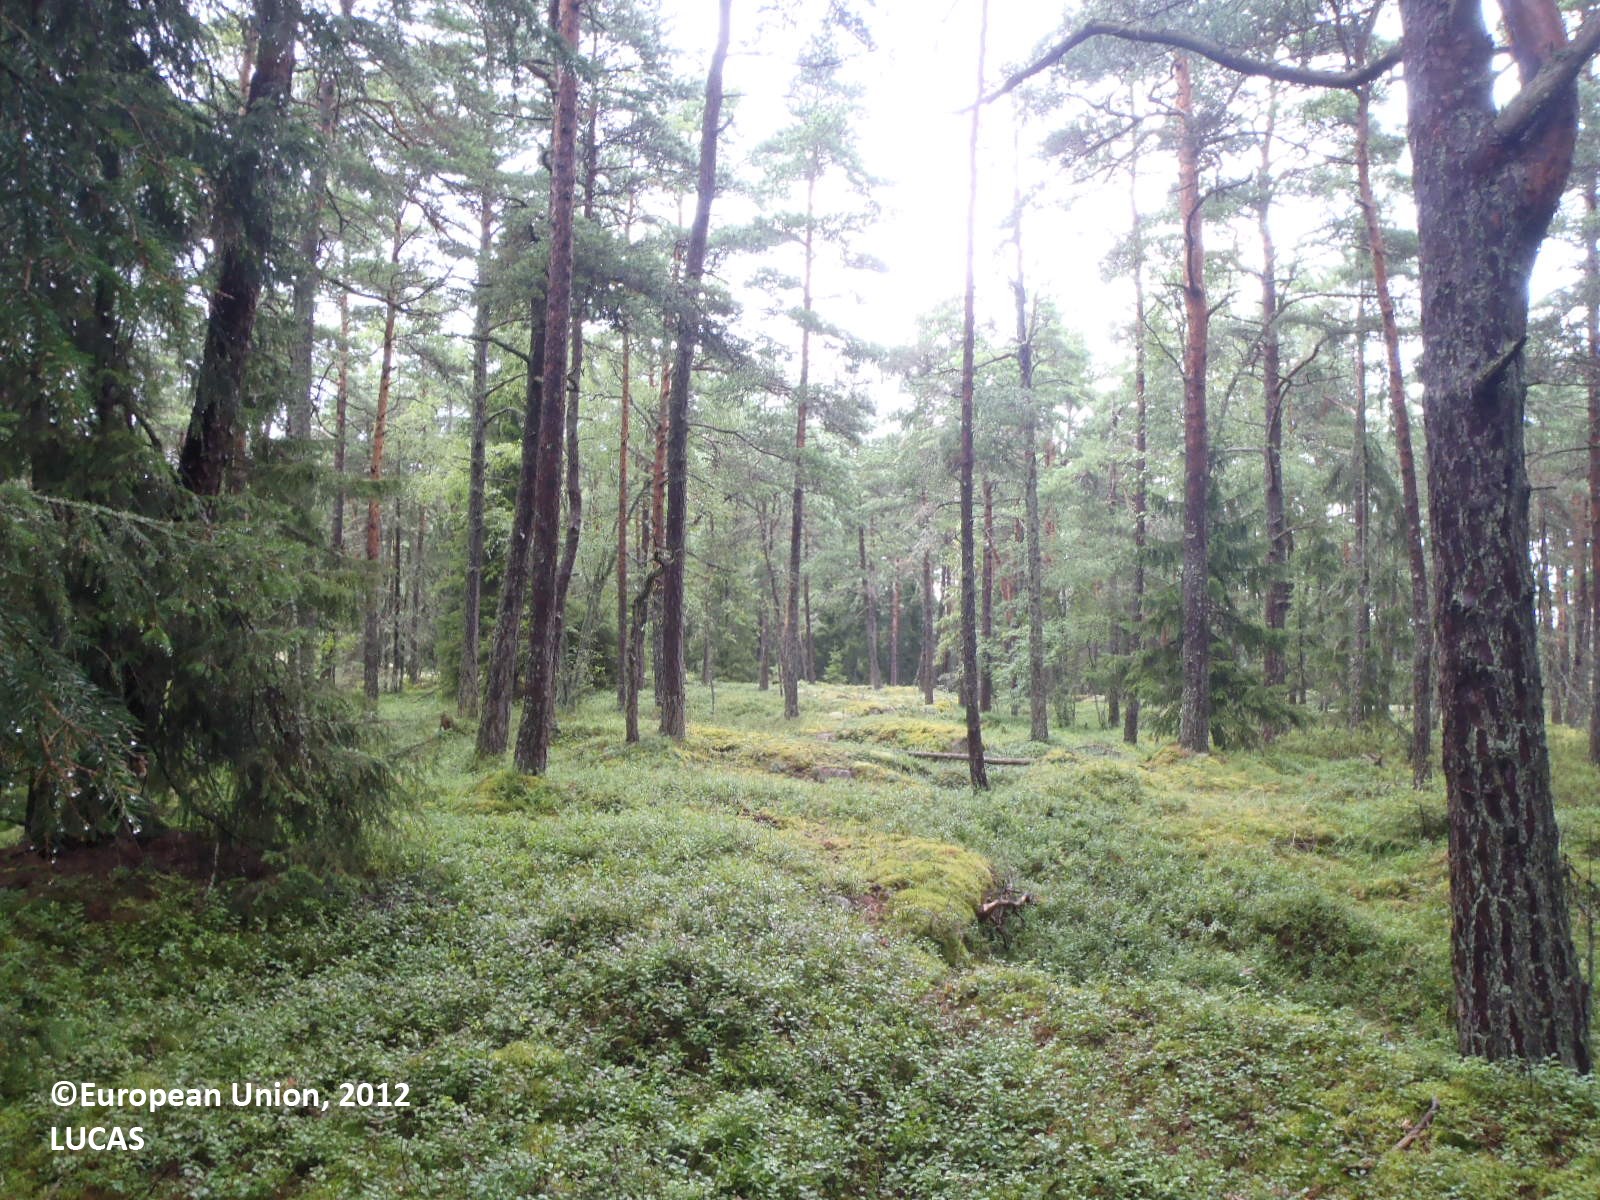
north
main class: Woodland
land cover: Pine dominated coniferous woodland
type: boreal forest
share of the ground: 50 - 75 %
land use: Forestry
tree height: > 5 m
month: August
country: FI
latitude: 60.1157
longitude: 19.9934
